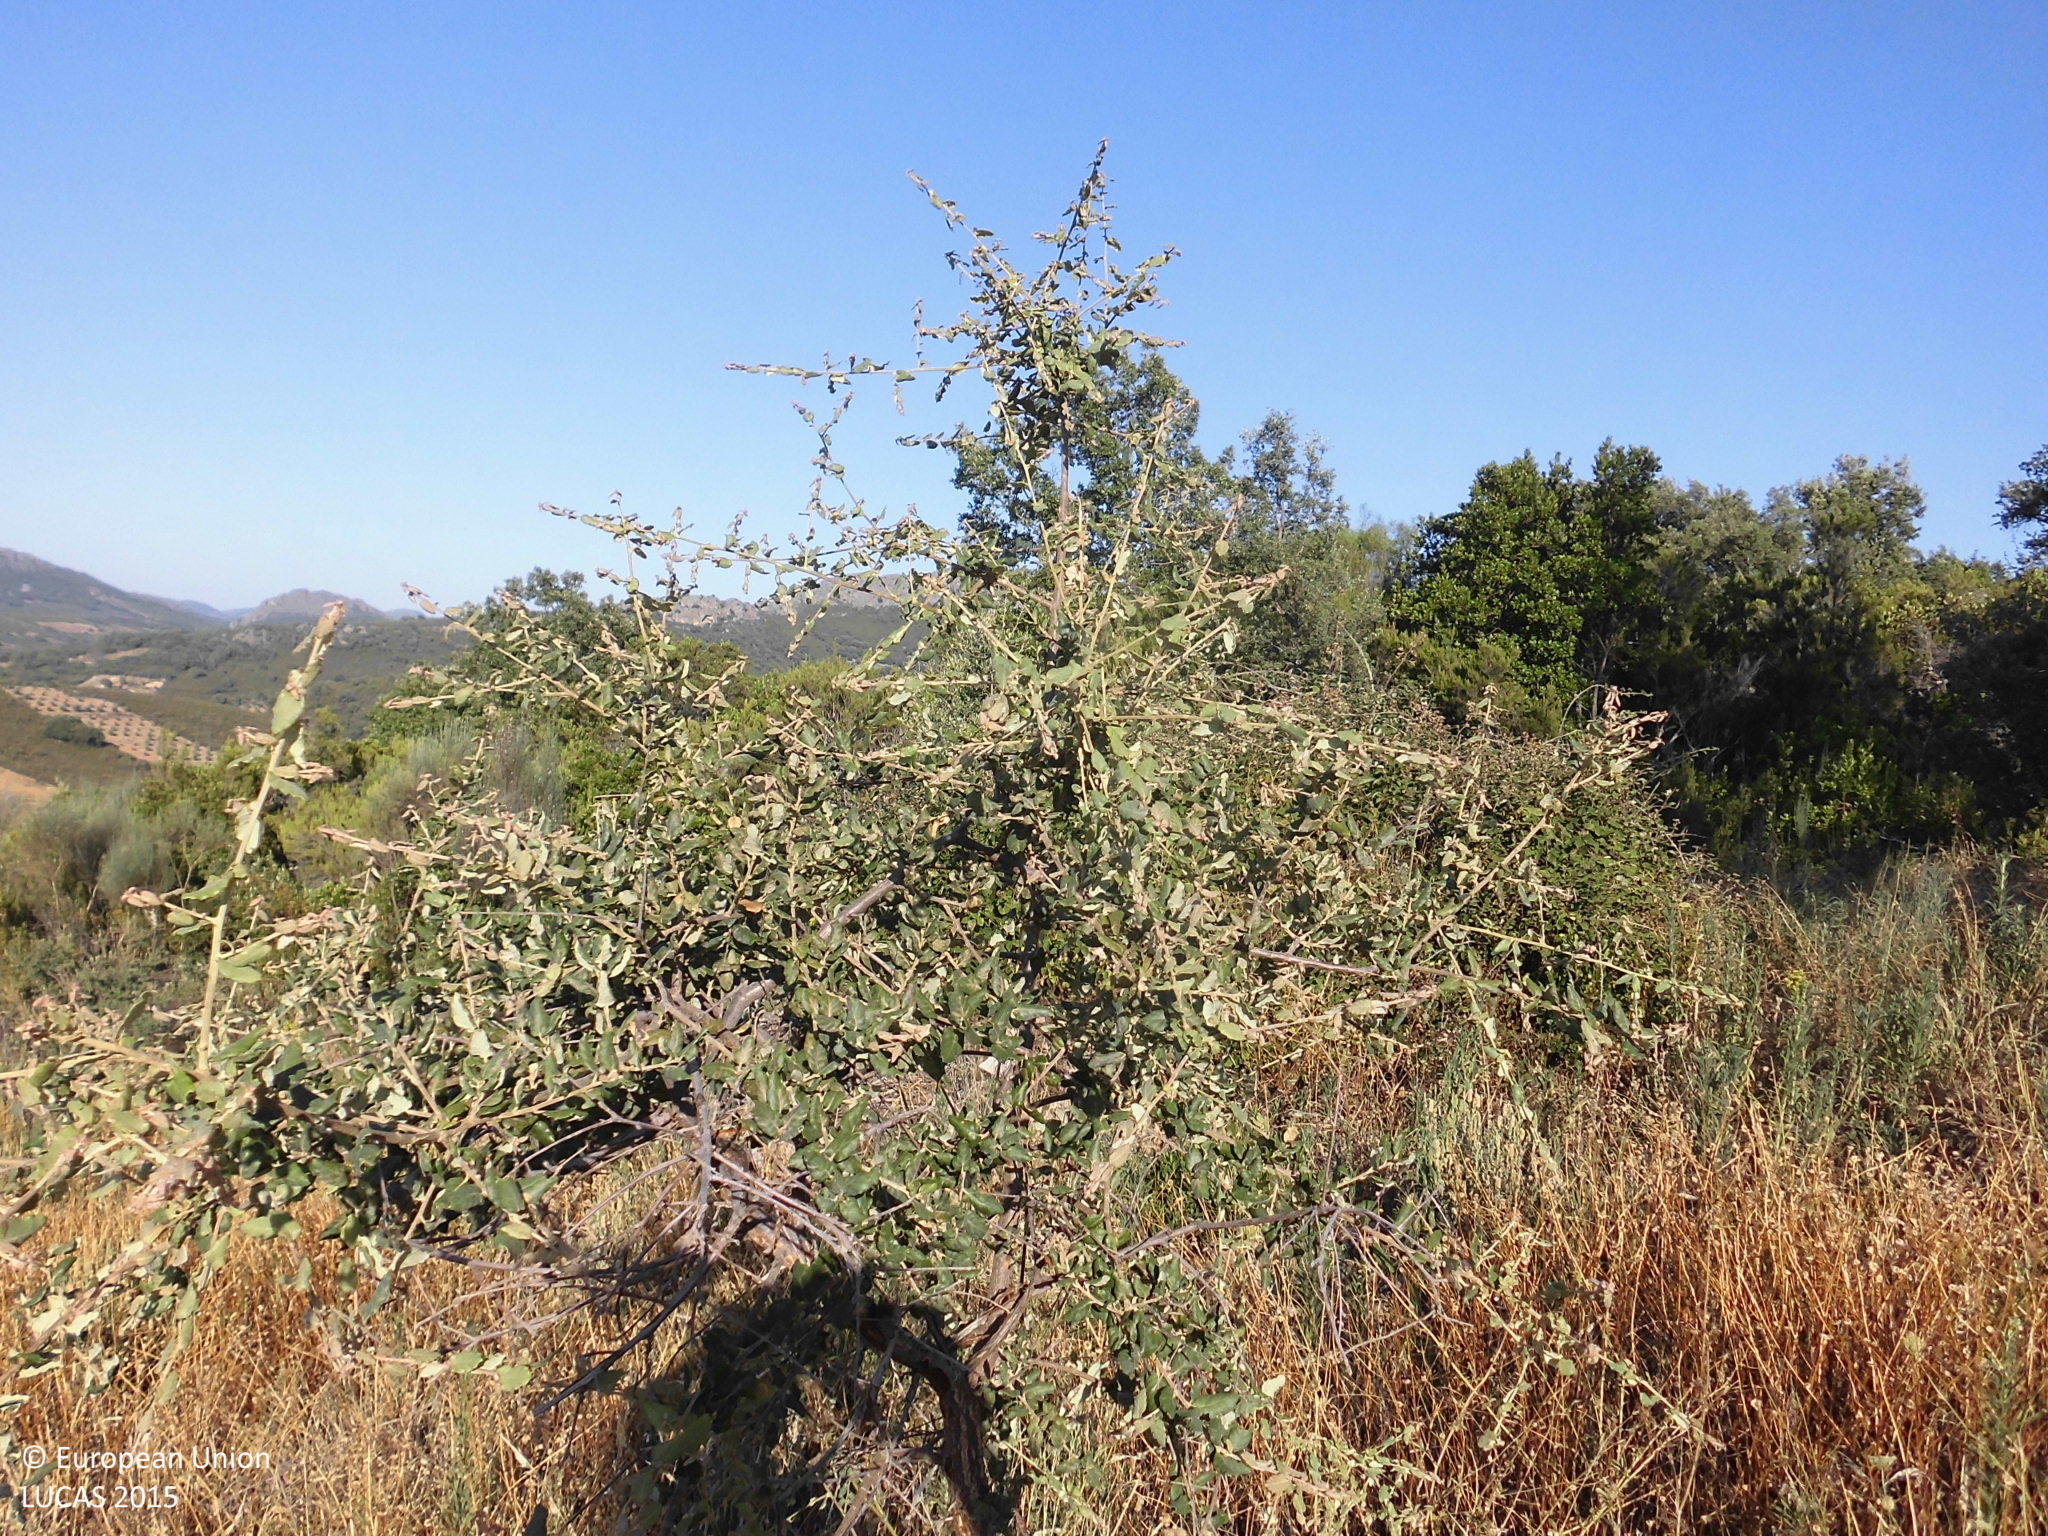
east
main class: Woodland
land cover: Broadleaved woodland
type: broadleaved evergreen forest
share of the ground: 10 - 25 %
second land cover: Grassland without tree/shrub cover
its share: > 75 %
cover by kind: herbaceous plants 90 %, broadleaved forest trees 10 %
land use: Forestry
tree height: < 5 m
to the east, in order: Broadleaved woodland; Grassland without tree/shrub cover; Shrubland with sparse tree cover; Olive groves; Fences; Shrubland with sparse tree cover; Fences; Olive groves
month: July
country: ES
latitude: 39.6063
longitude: -5.5564
